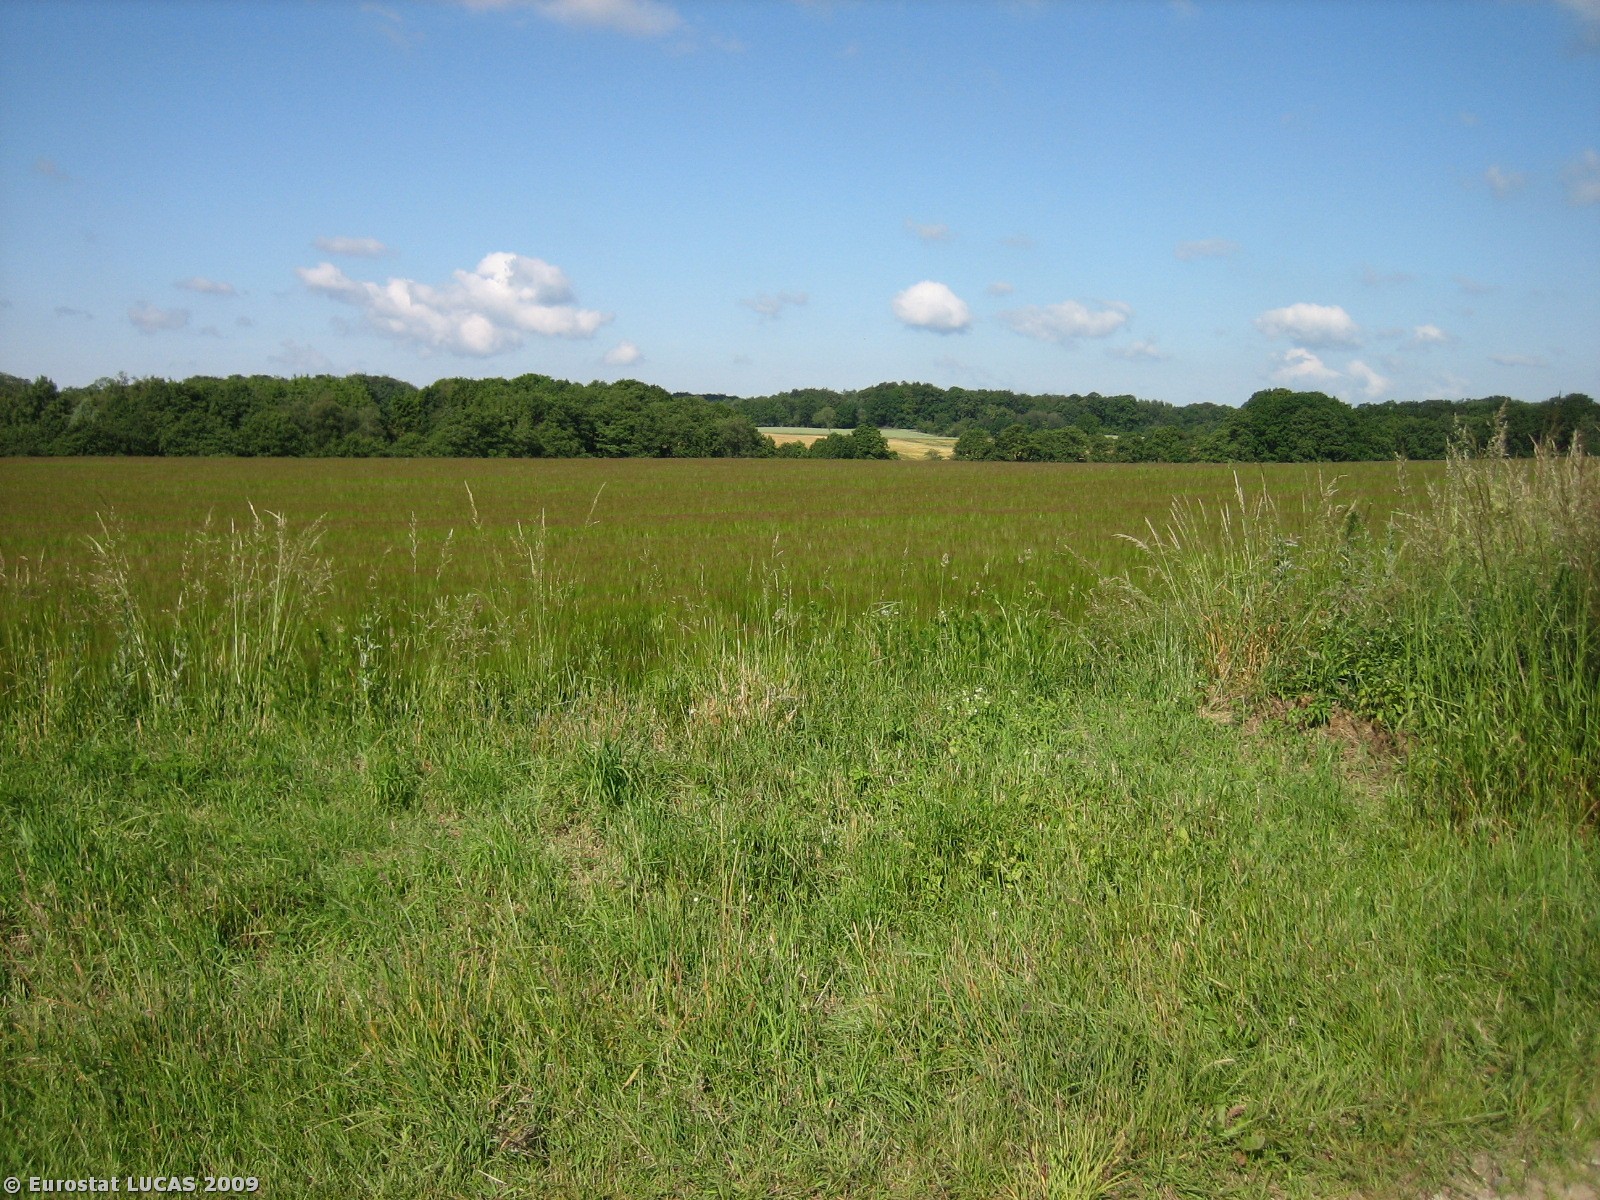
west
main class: Cropland
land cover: Barley
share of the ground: > 75 %
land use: Agriculture (excluding fallow land and kitchen gardens)
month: June
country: DK
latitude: 55.5207
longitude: 9.2879
